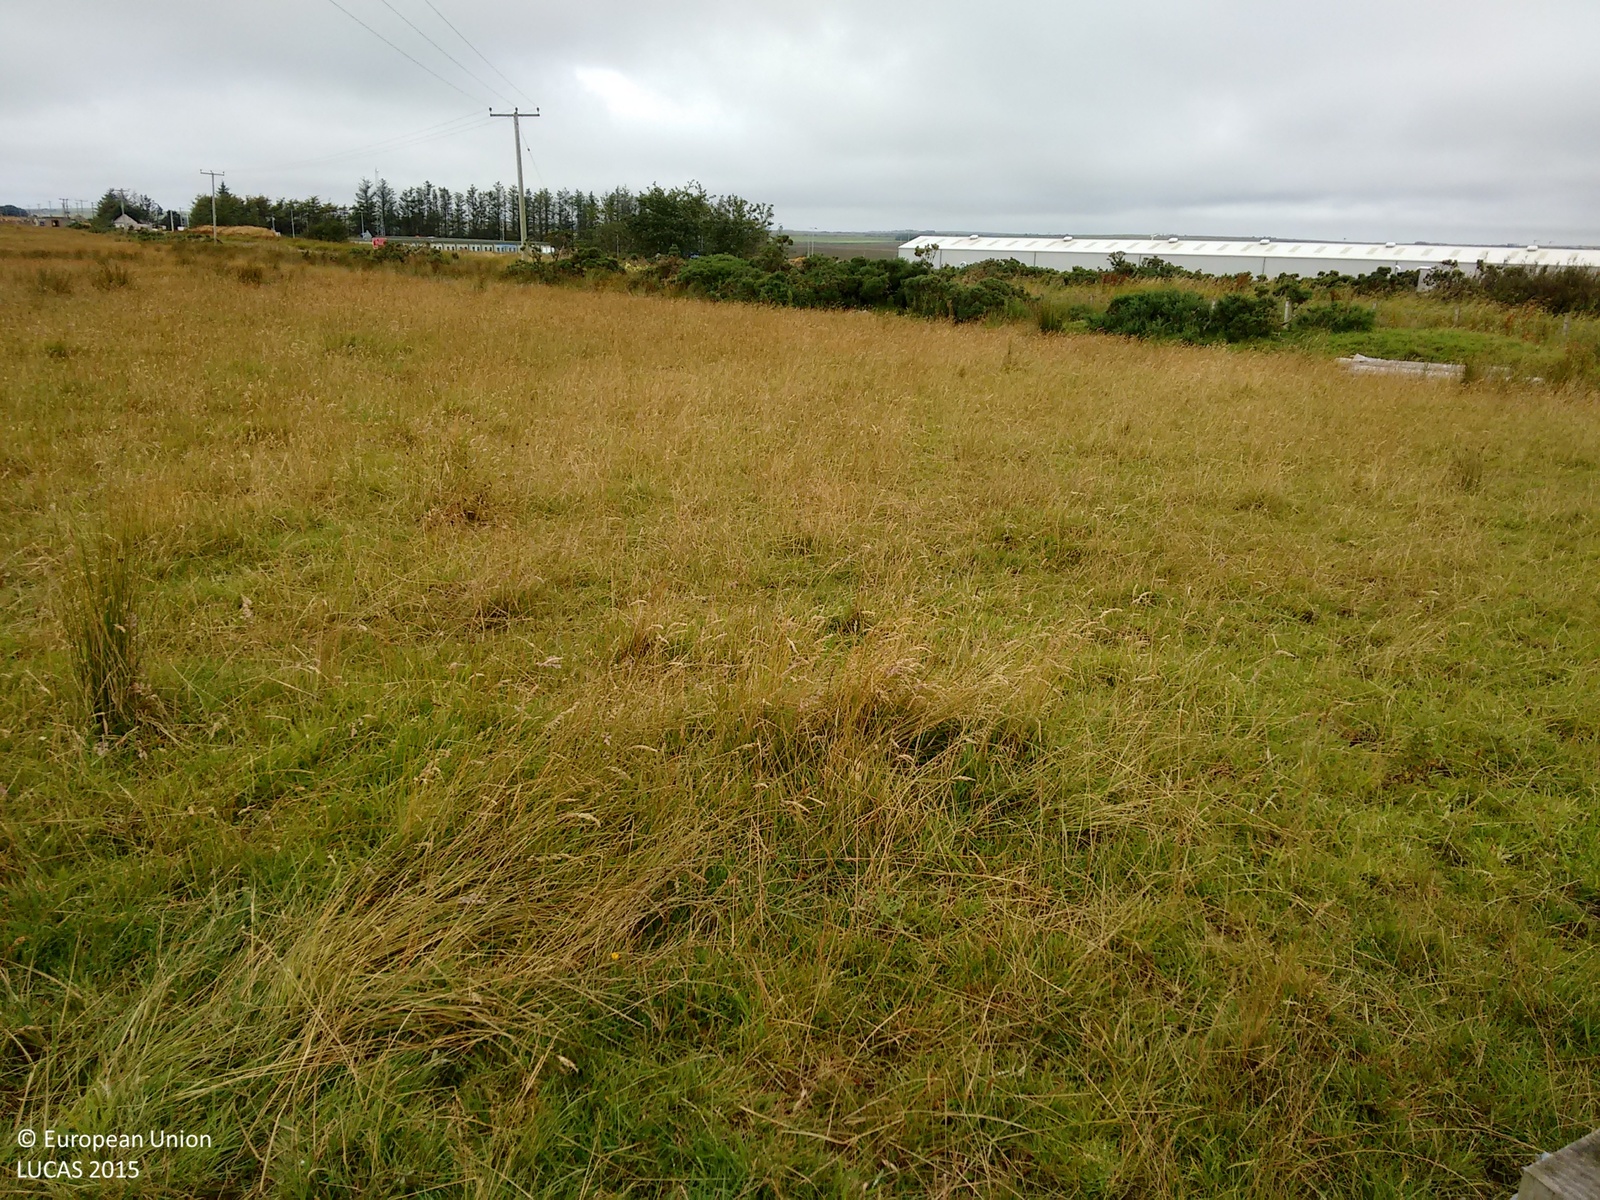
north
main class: Grassland
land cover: Grassland without tree/shrub cover
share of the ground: > 75 %
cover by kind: herbaceous plants 100 %
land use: Agriculture (excluding fallow land and kitchen gardens)
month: August
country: GB
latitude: 58.5264
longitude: -3.2655
